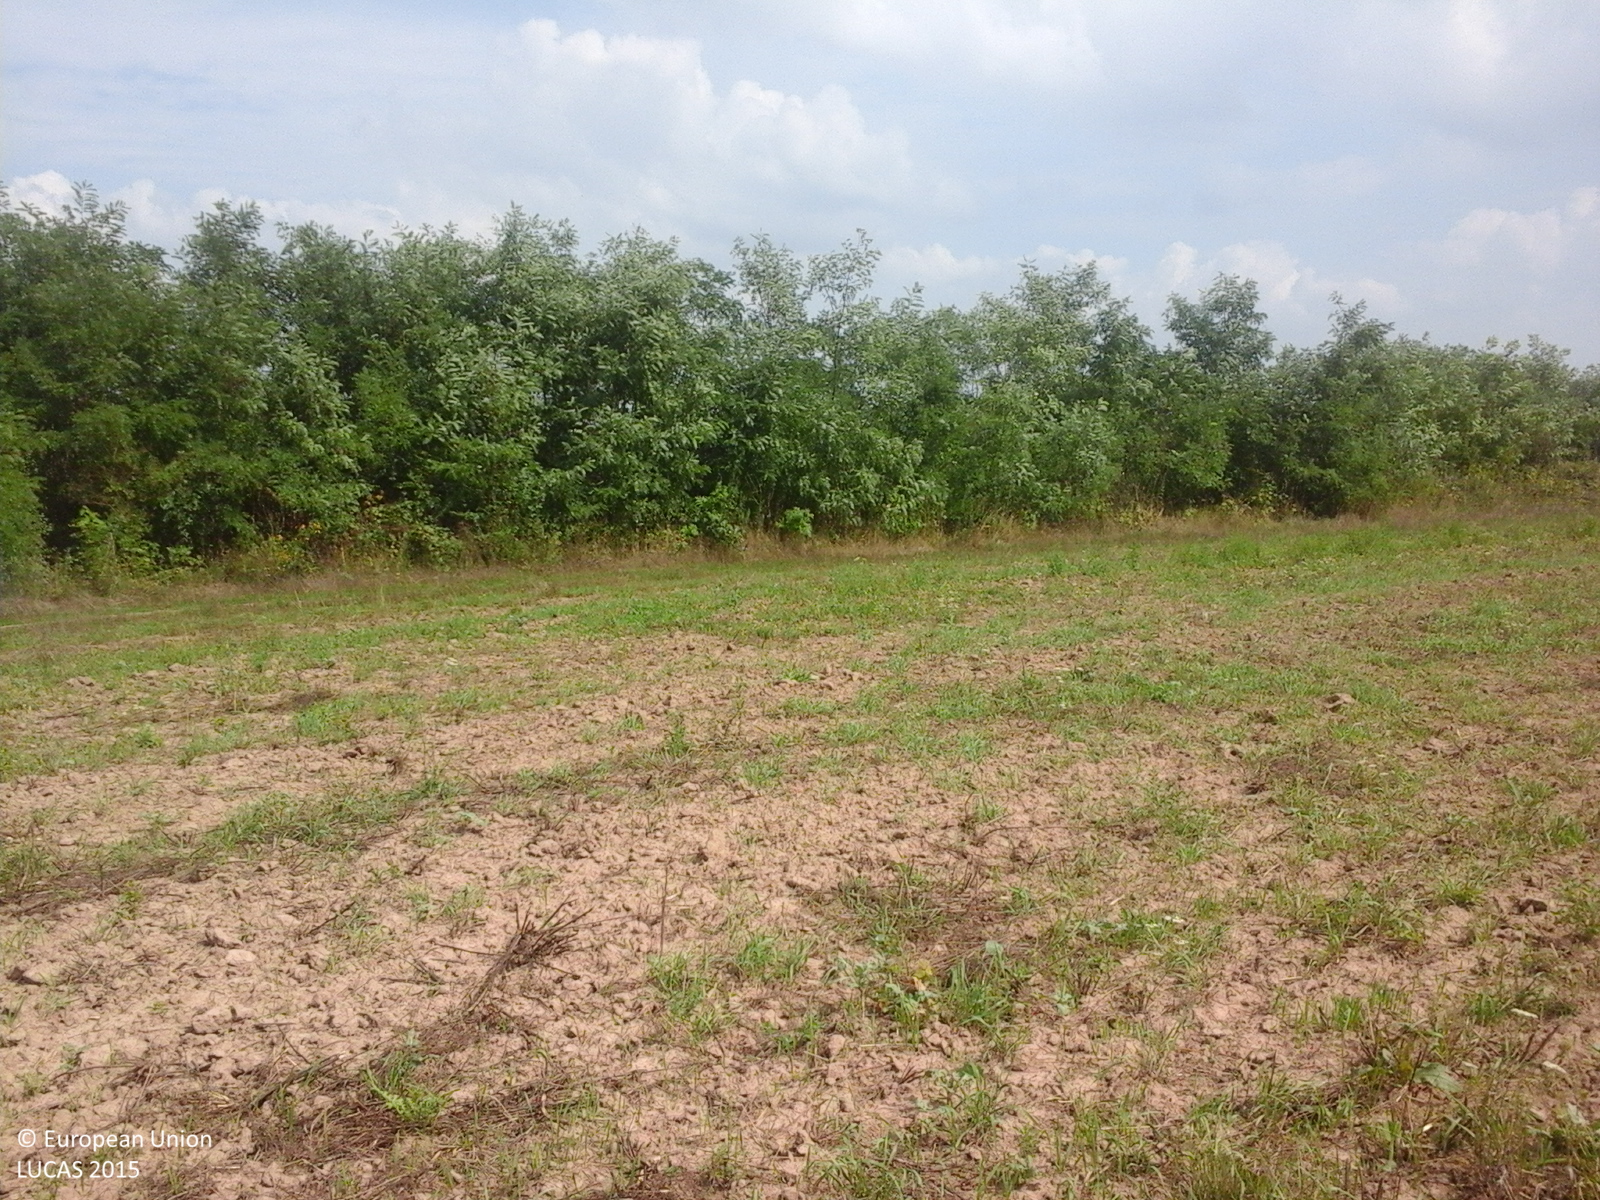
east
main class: Grassland
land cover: Spontaneously vegetated surfaces
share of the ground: 25 - 50 %
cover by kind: herbaceous plants 100 %
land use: Fallow land
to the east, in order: Spontaneously vegetated surfaces; Tracks; Grass margins; Shrubland with sparse tree cover; Ditches and canals; Shrubland with sparse tree cover; Spontaneously vegetated surfaces; Shrubland with sparse tree cover; Ditches and canals; Shrubland with sparse tree cover; Maize; Spontaneously vegetated surfaces; Ditches and canals; Shrubland with sparse tree cover
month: August
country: RO
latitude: 46.5720
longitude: 21.7713
